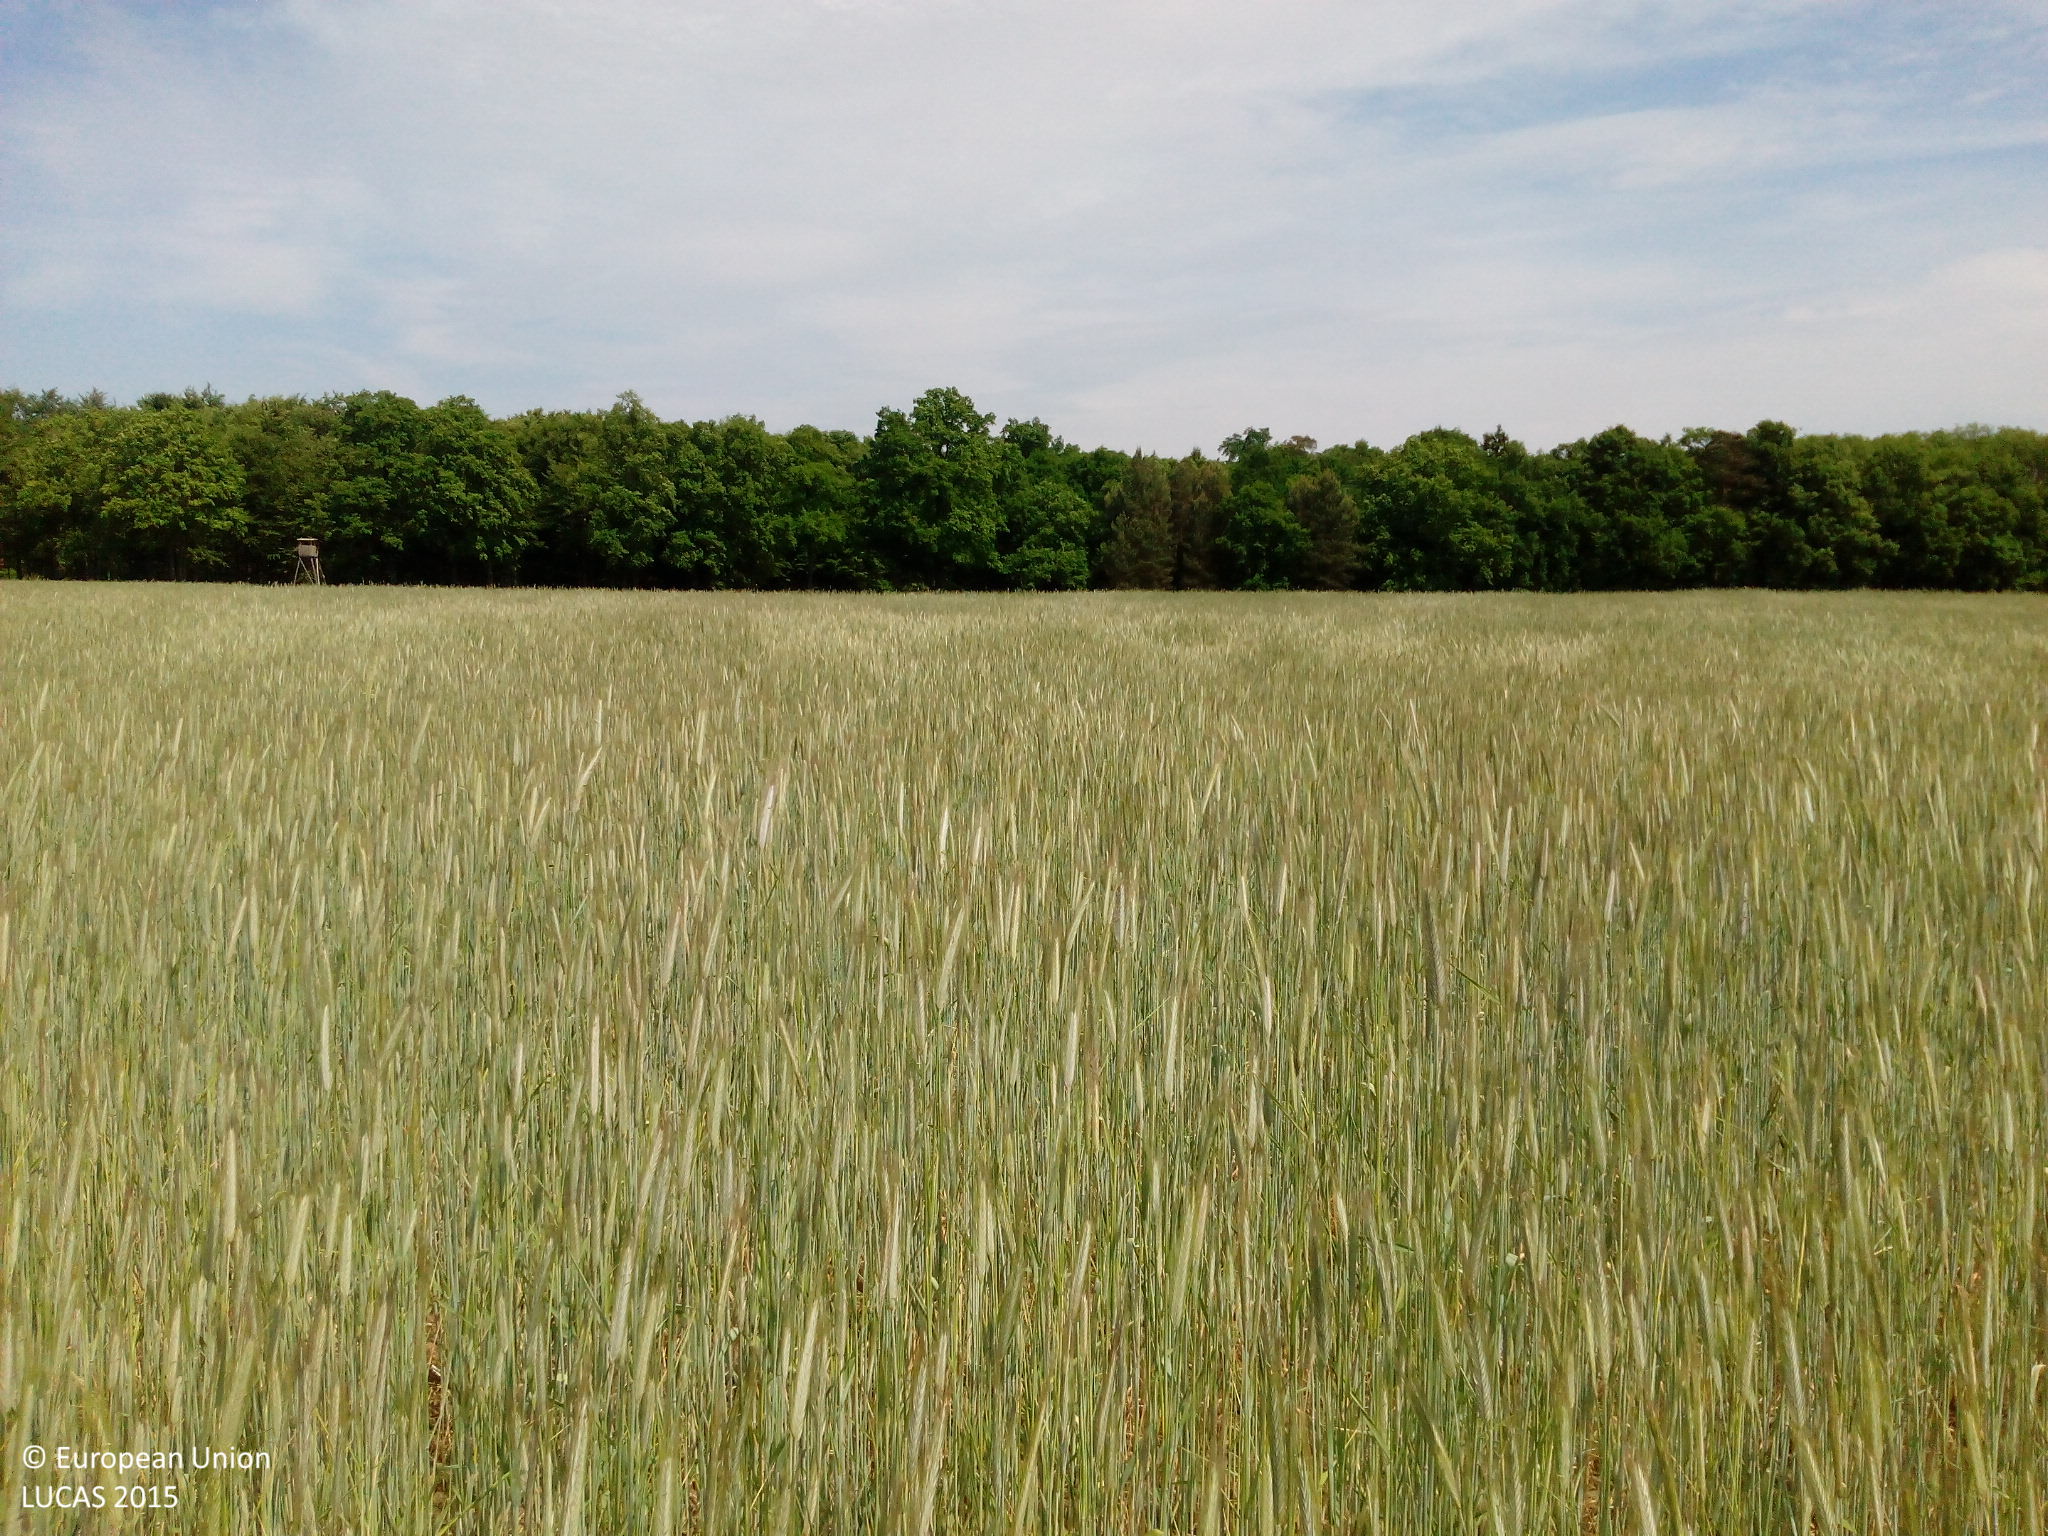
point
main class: Cropland
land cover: Rye
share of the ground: > 75 %
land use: Agriculture (excluding fallow land and kitchen gardens)
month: May
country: DE
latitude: 51.6790
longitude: 14.0360
